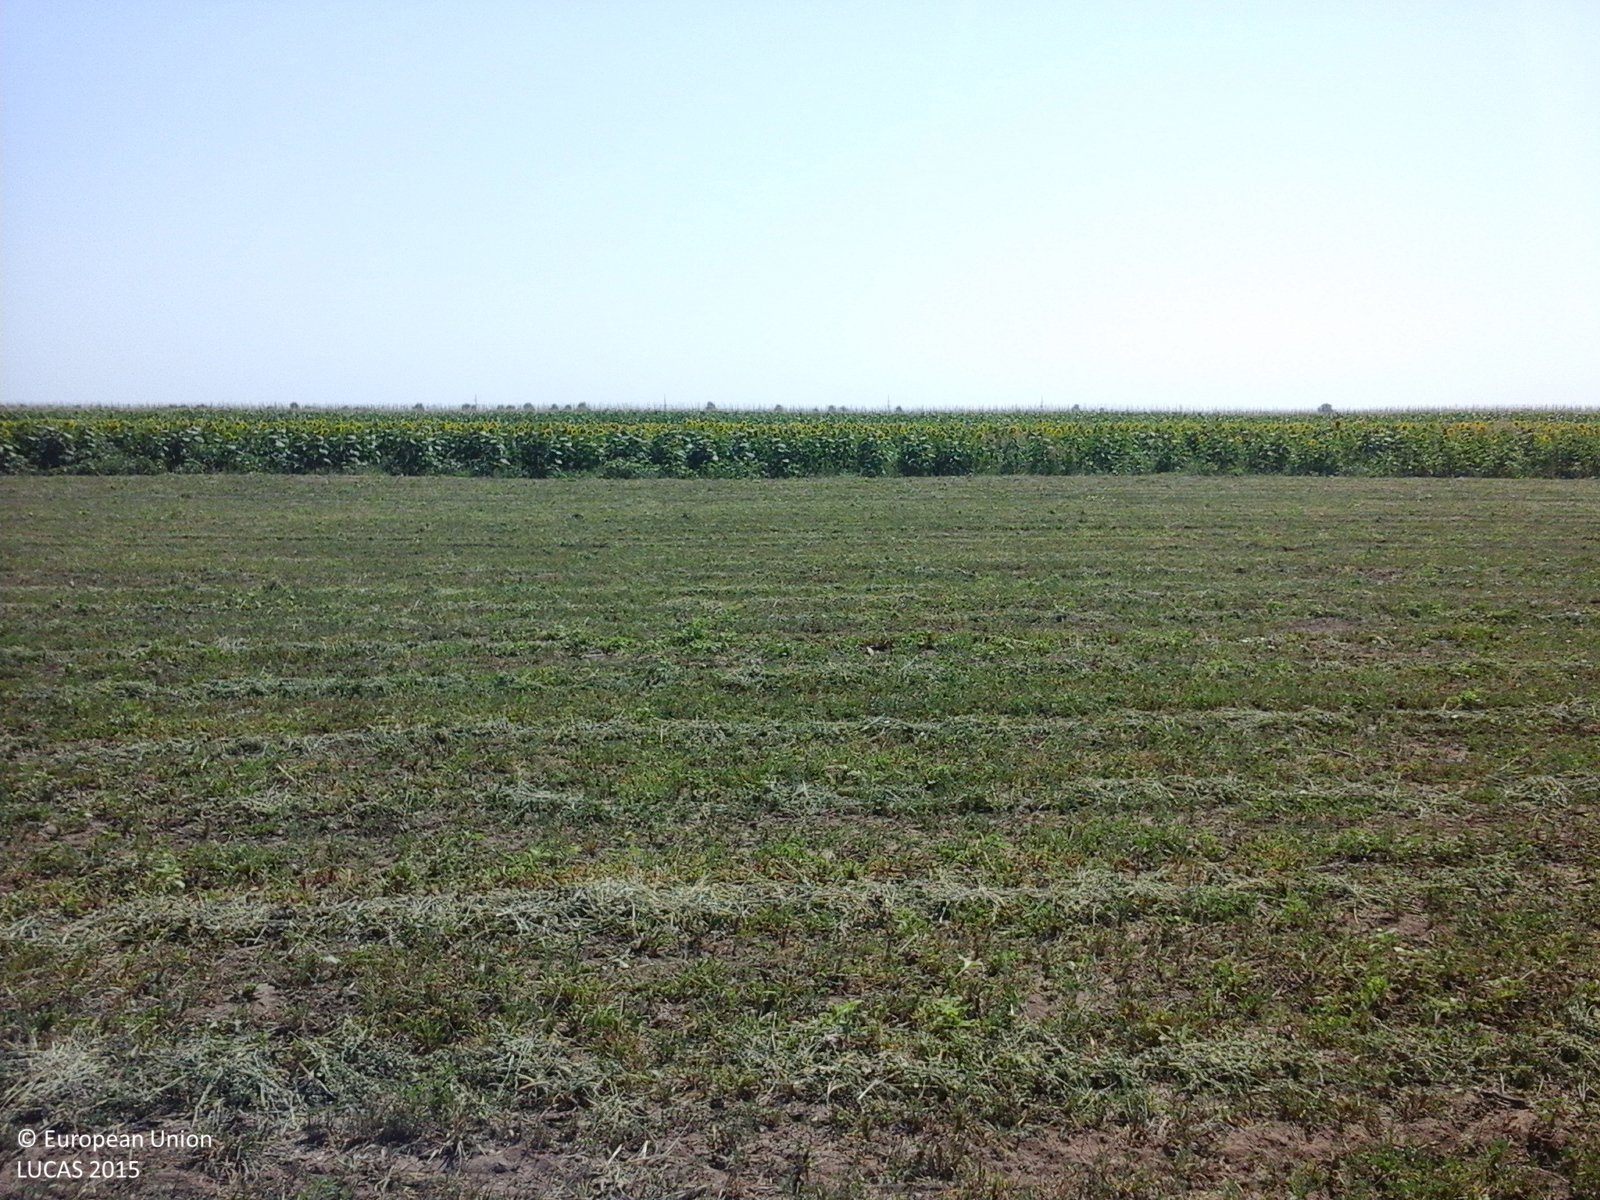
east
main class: Cropland
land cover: Lucerne
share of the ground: 25 - 50 %
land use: Agriculture (excluding fallow land and kitchen gardens)
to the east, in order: Lucerne; Sunflower; Maize; Sunflower
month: July
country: RO
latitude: 45.0609
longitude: 27.2738
